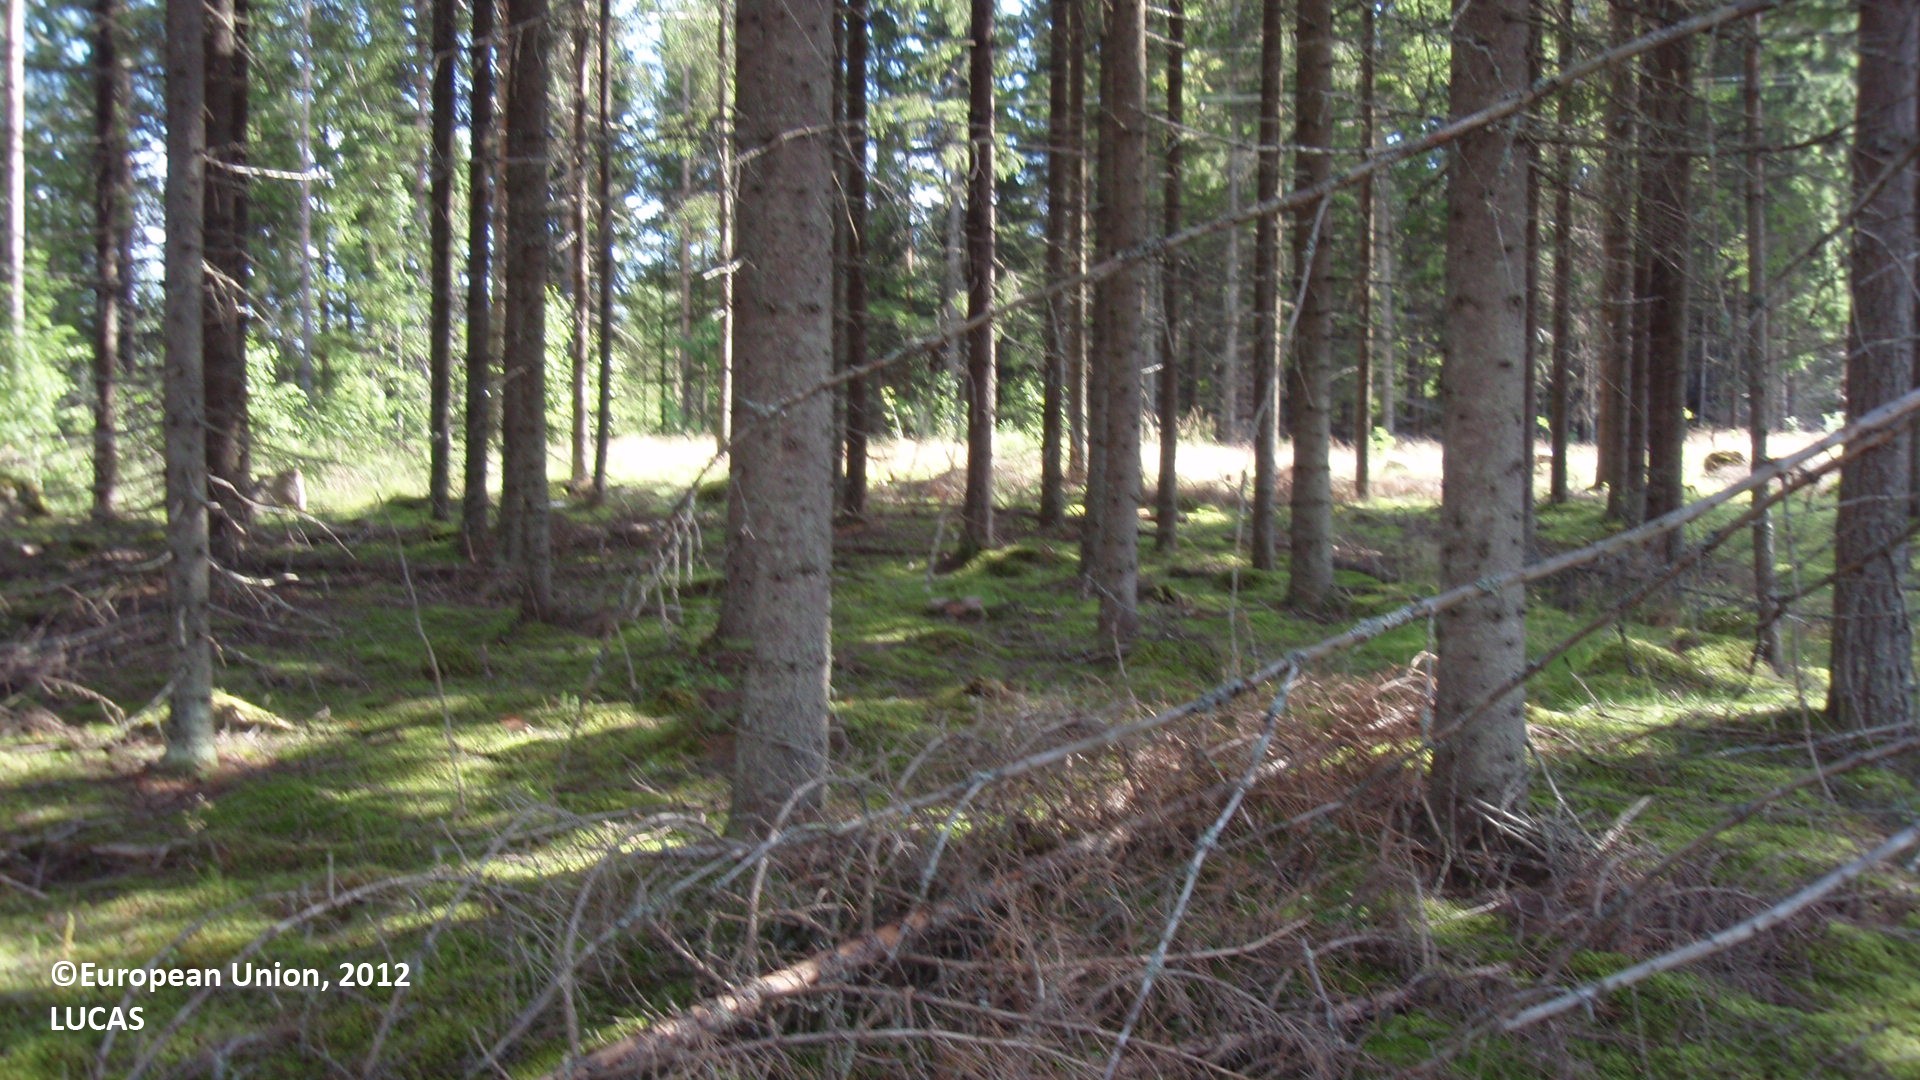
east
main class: Woodland
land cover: Spruce dominated coniferous woodland
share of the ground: 50 - 75 %
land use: Forestry
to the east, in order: Spruce dominated coniferous woodland; Grassland with sparse tree/shrub cover; Tracks; Shrubland with sparse tree cover; Electric lines; Shrubland with sparse tree cover; Spruce dominated mixed woodland; Broadleaved woodland
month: July
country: FI
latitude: 61.4294
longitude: 29.0722
